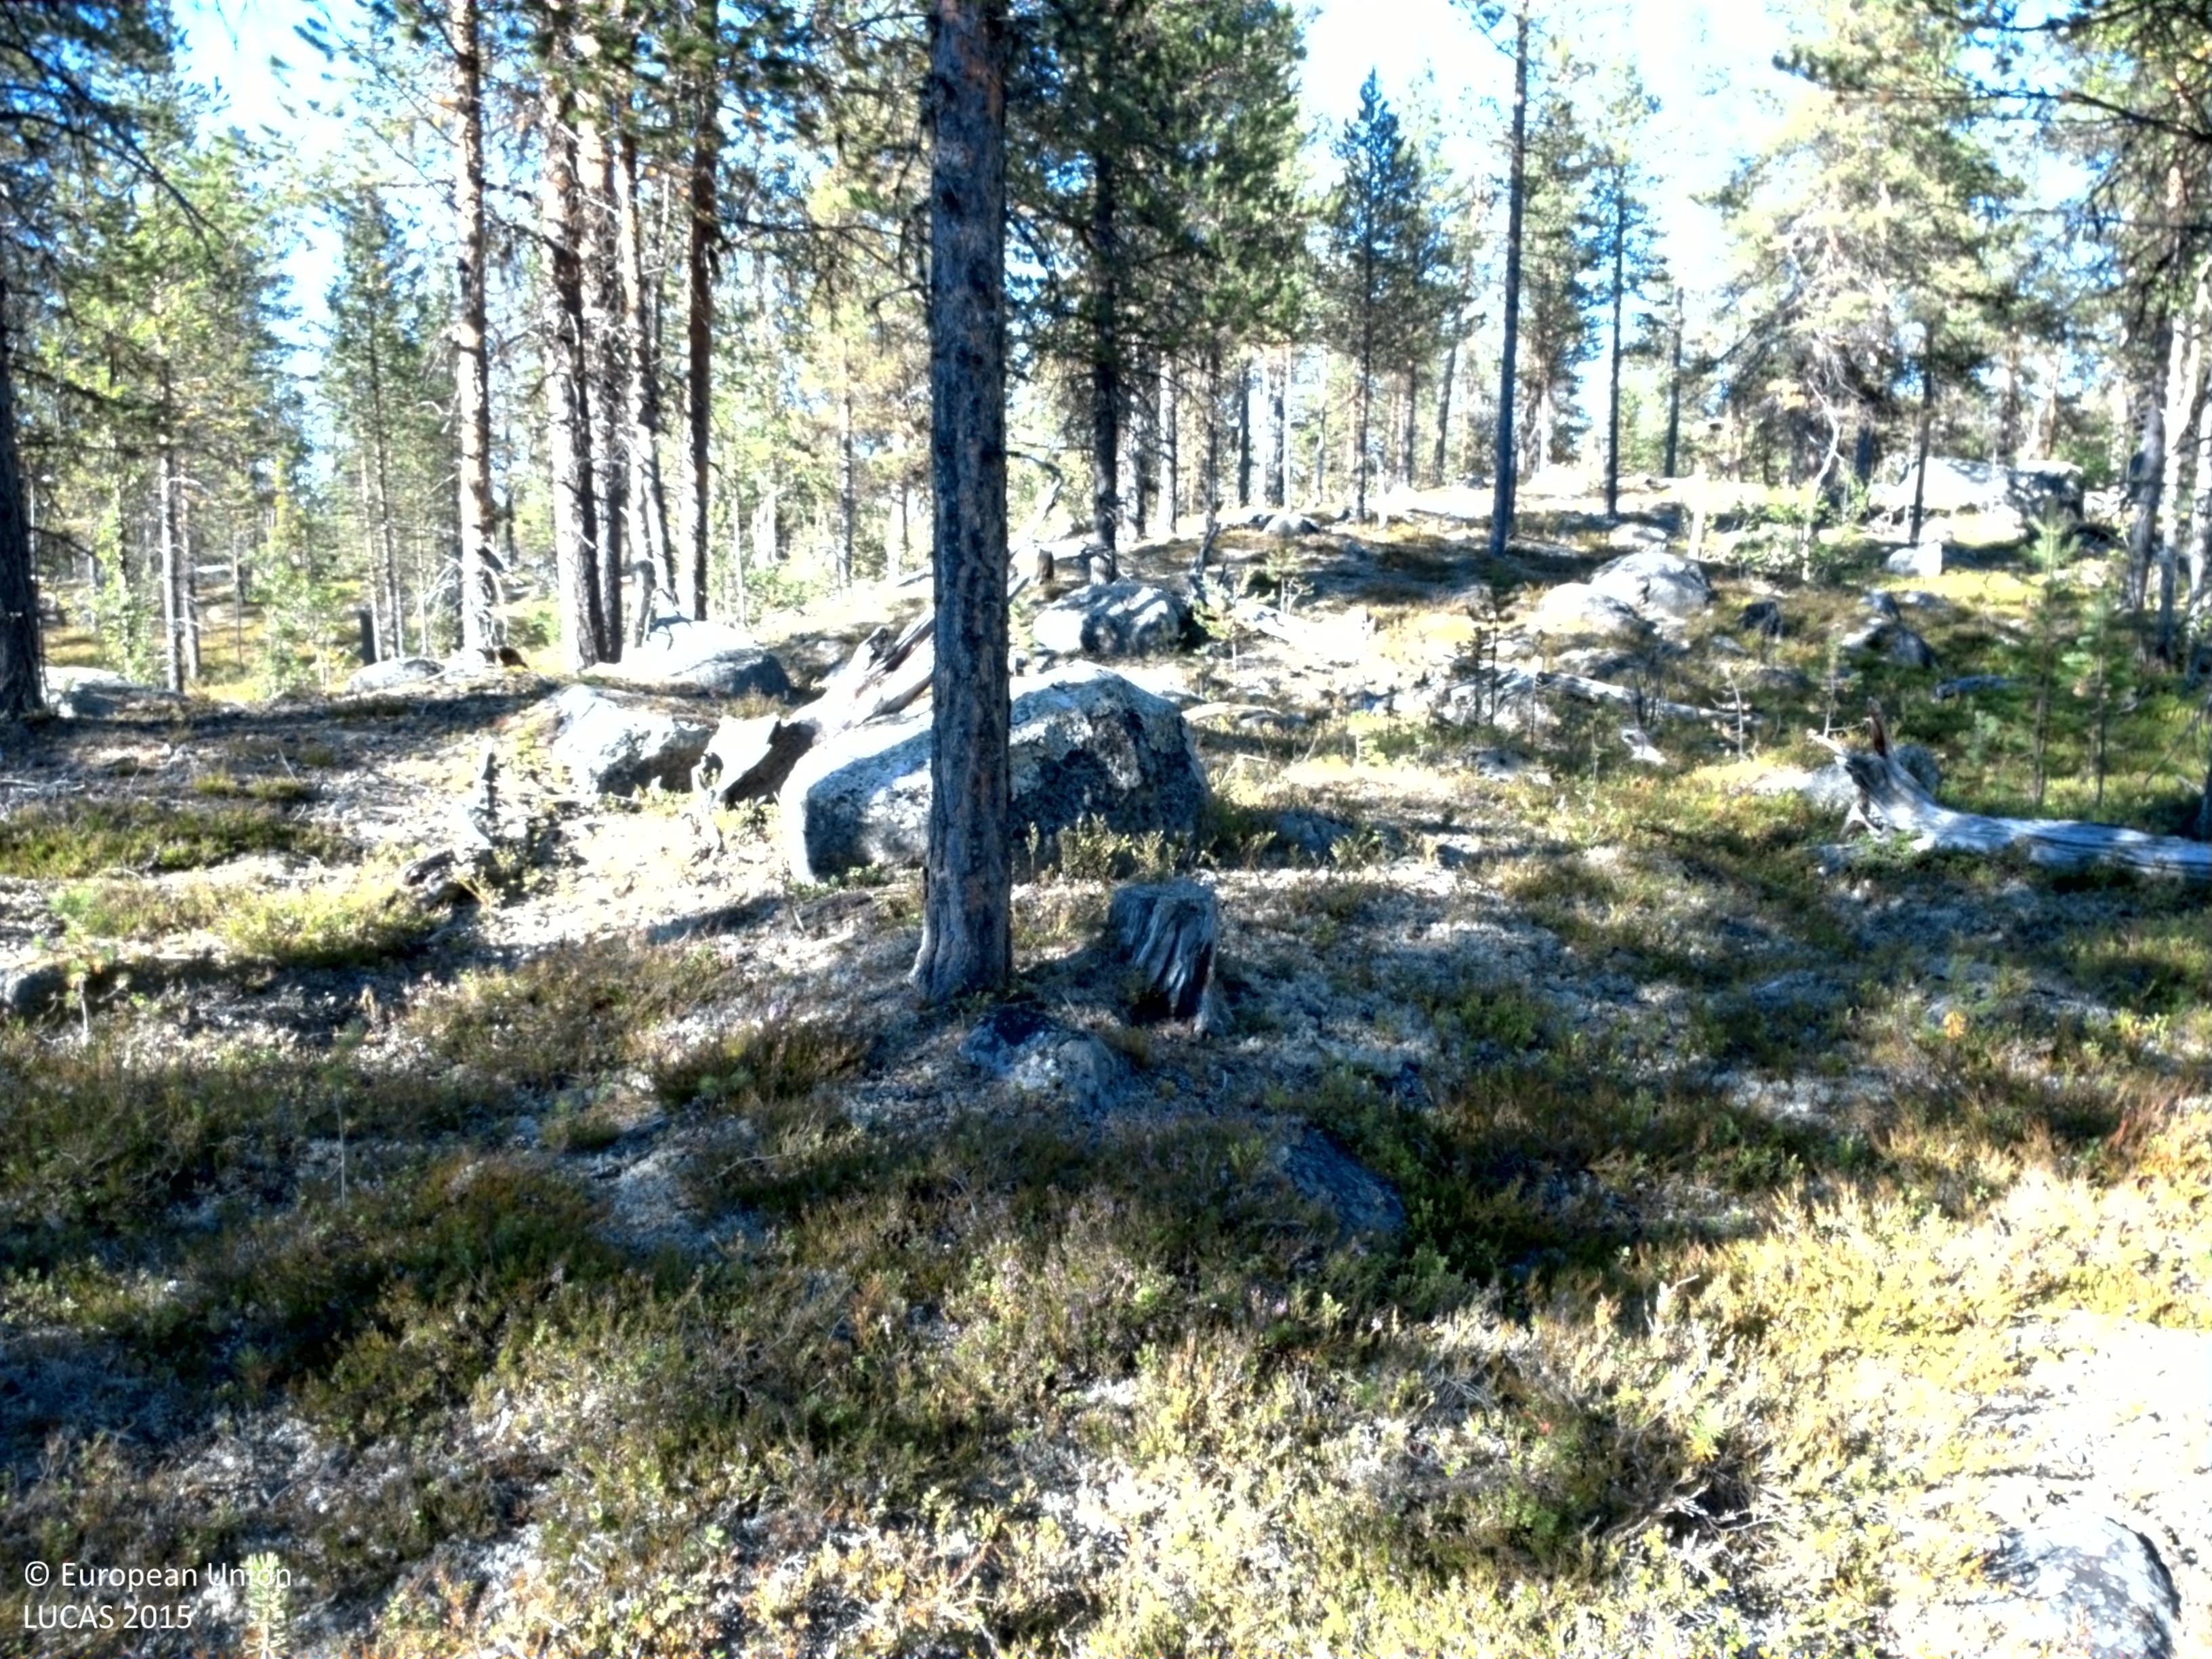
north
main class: Woodland
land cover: Pine dominated mixed woodland
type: boreal forest
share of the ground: 25 - 50 %
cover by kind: shrubs 50 %, coniferous forest trees 15 %, lichens and mosses 15 %, broadleaved forest trees 10 %, consolidated bare surface 10 %
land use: Forestry
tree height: > 5 m
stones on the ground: 25 - 50 %
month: August
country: SE
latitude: 66.6957
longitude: 18.9423
